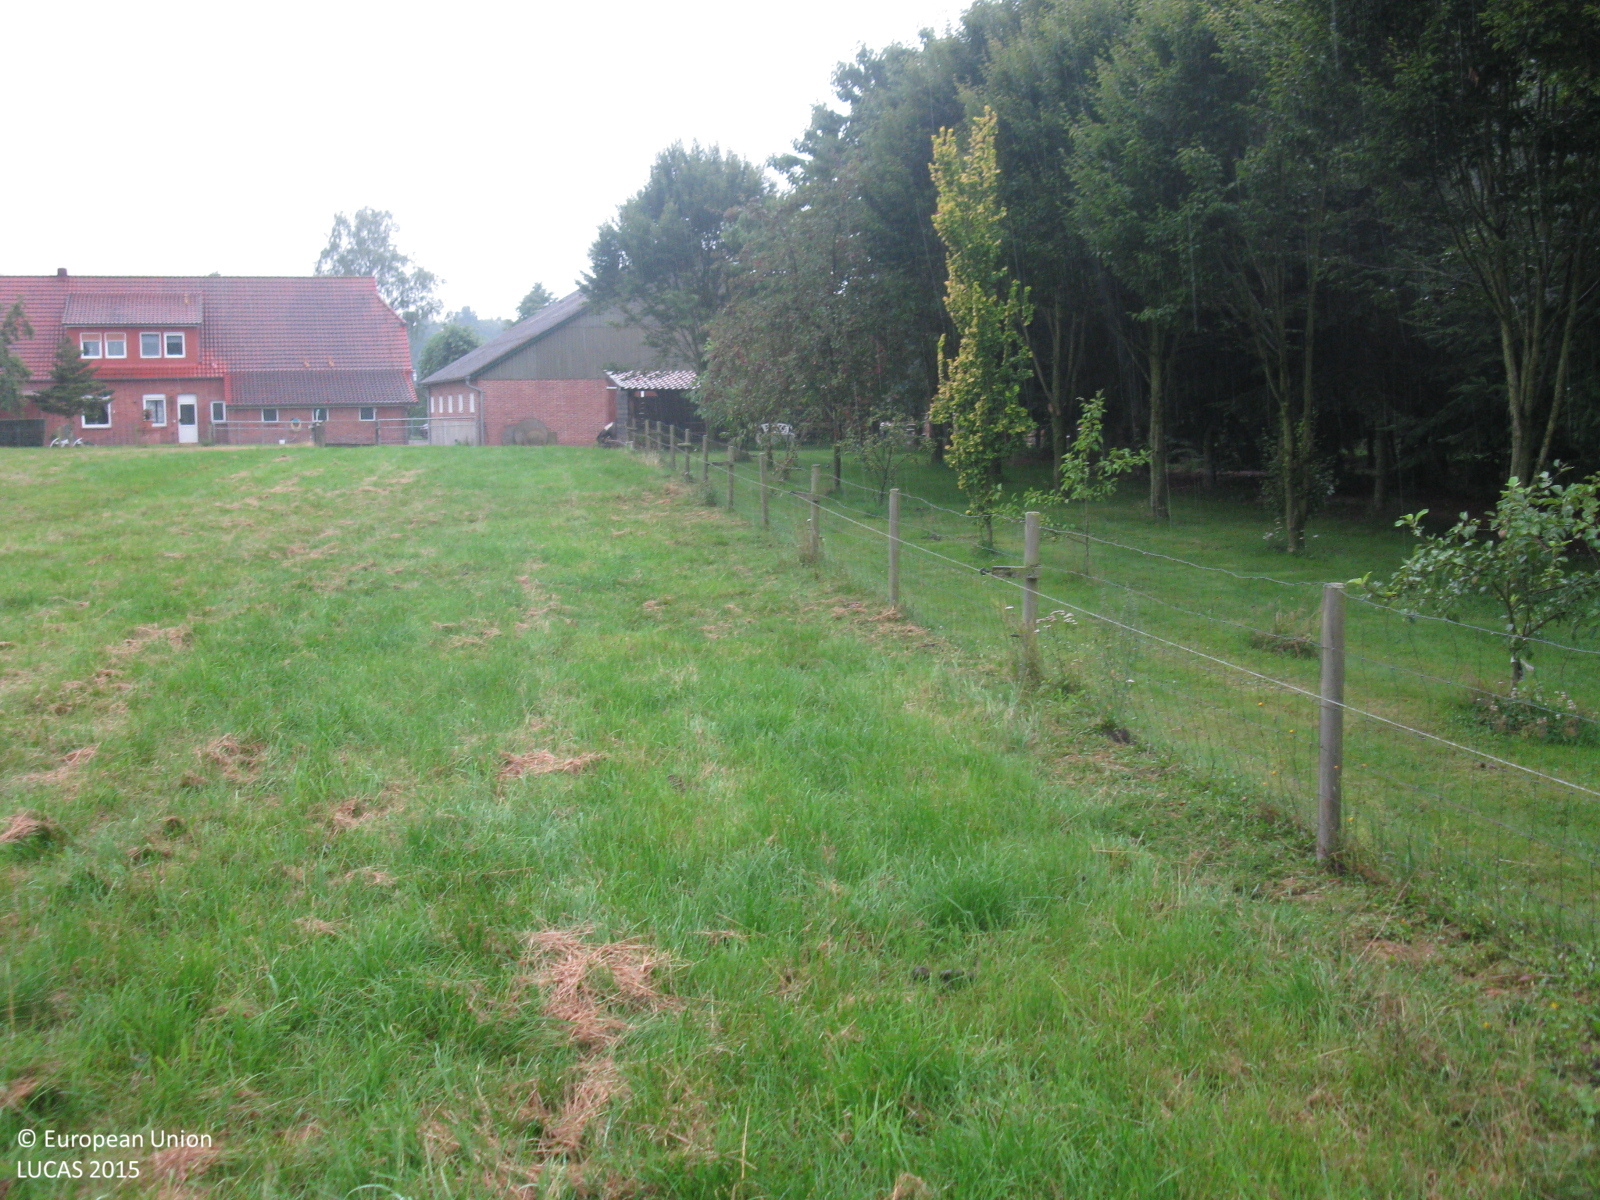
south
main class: Cropland
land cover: Maize
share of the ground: > 75 %
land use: Agriculture (excluding fallow land and kitchen gardens)
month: August
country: DE
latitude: 52.9772
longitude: 8.3475
